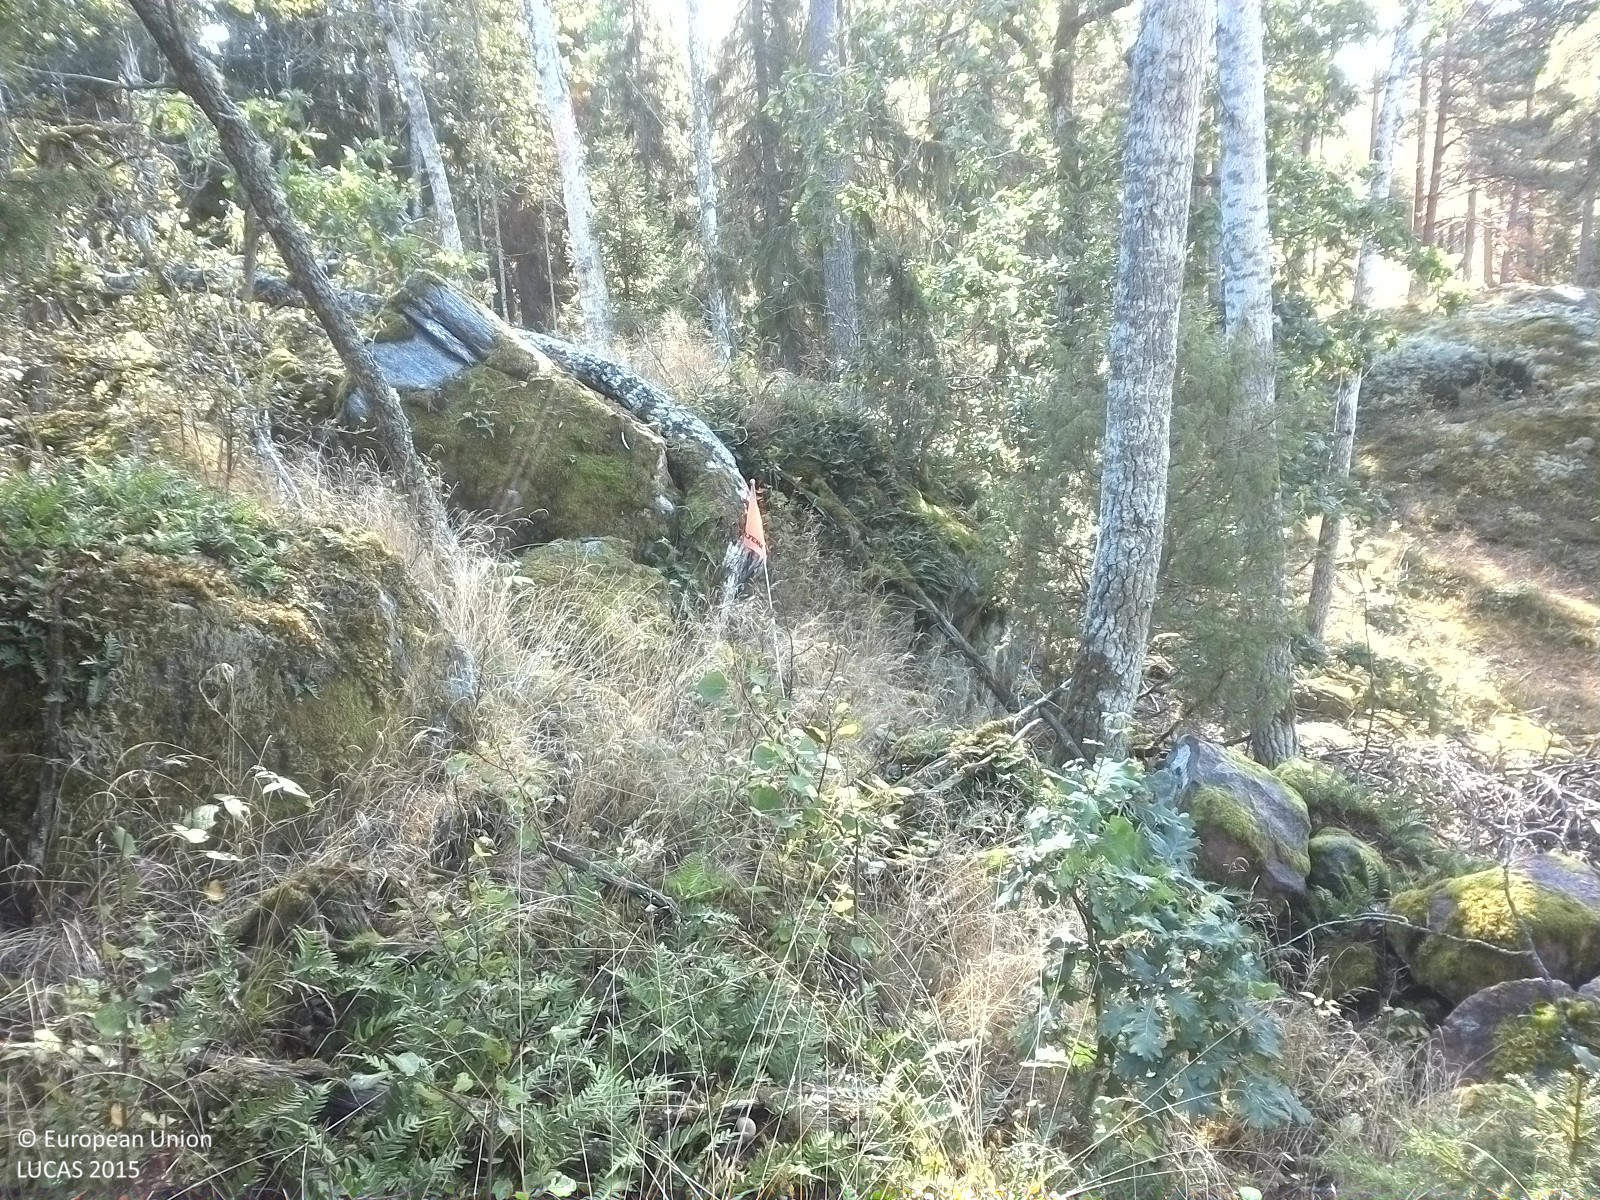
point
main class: Woodland
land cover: Broadleaved woodland
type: hemiboreal forest and nemoral coniferous forest and mixed broadleaved-coniferous forest
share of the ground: 25 - 50 %
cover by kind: herbaceous plants 35 %, broadleaved forest trees 30 %, lichens and mosses 20 %, shrubs 10 %, coniferous forest trees 5 %
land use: Forestry
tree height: > 5 m
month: September
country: SE
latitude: 58.4805
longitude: 16.8055
